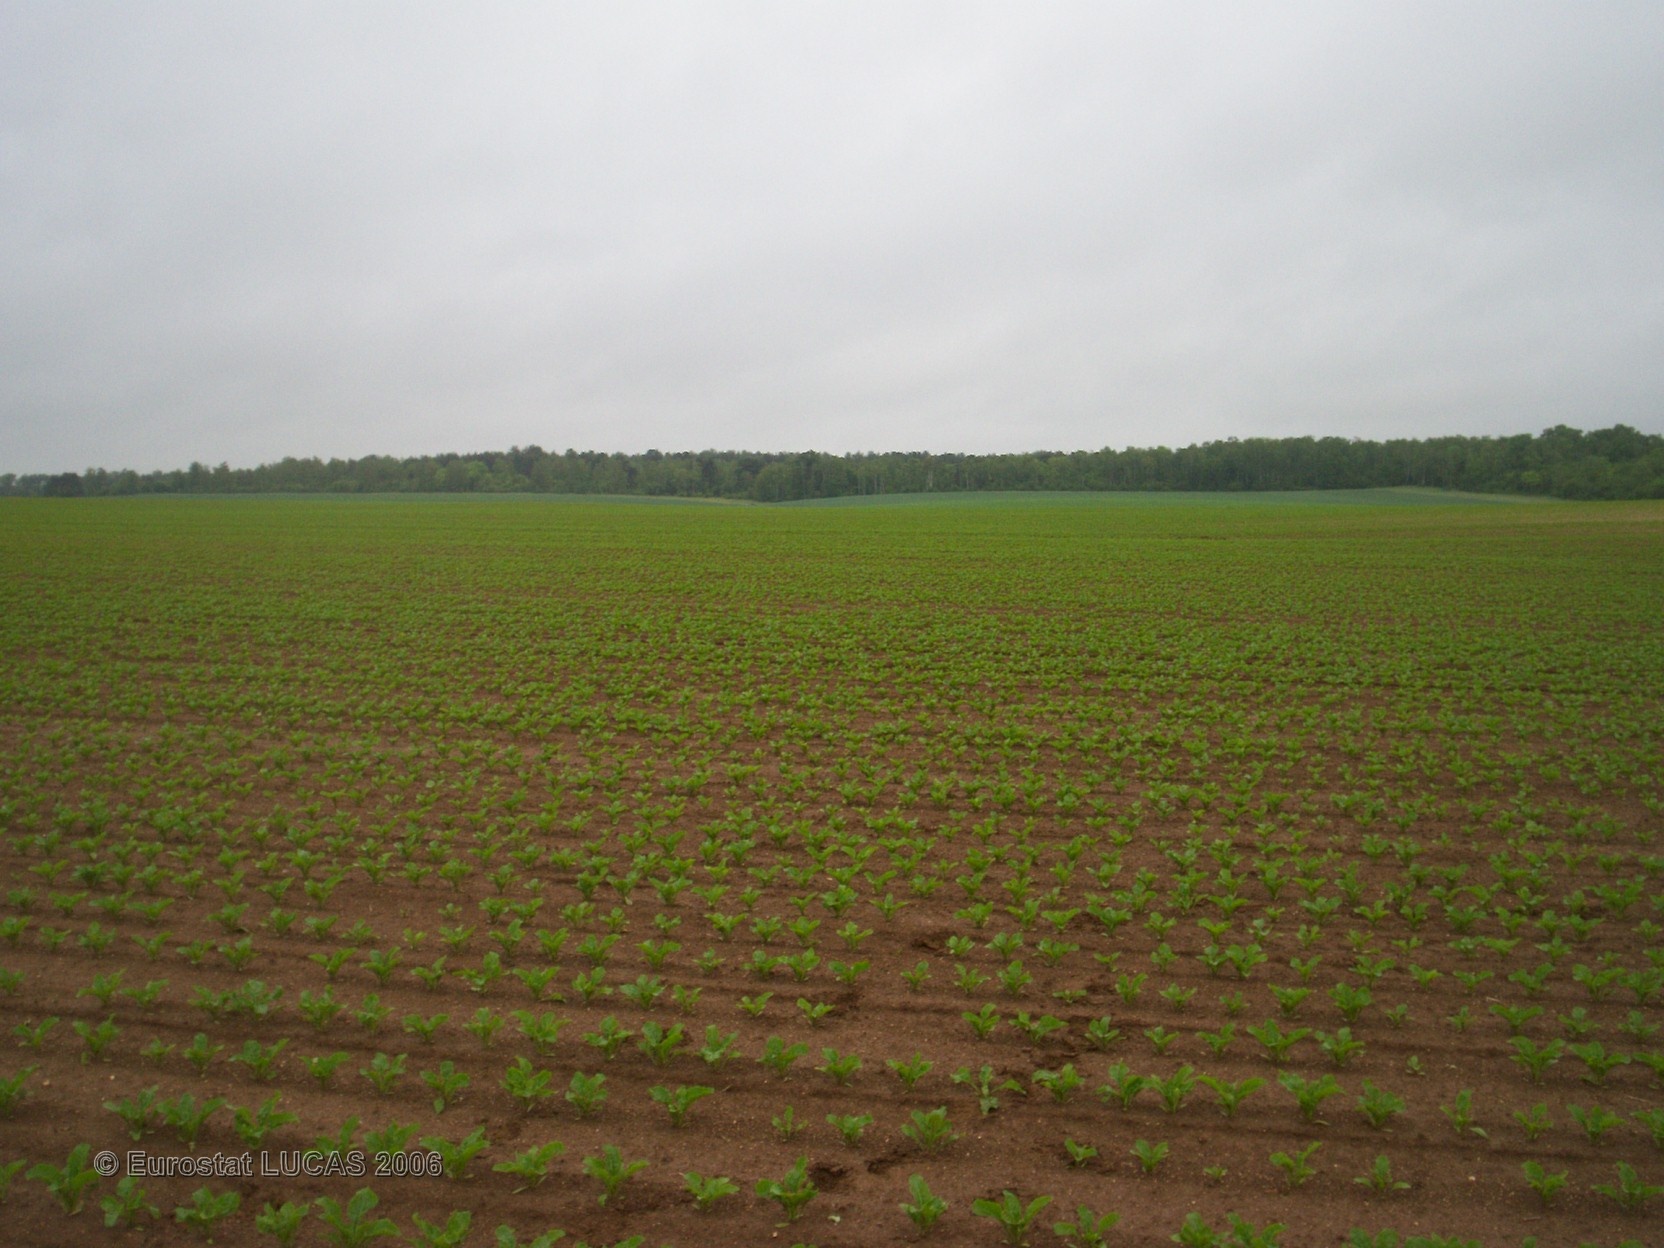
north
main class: Cropland
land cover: Sugar beet
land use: Agriculture (excluding fallow land and kitchen gardens)
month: May
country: FR
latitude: 49.4150
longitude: 4.3859
